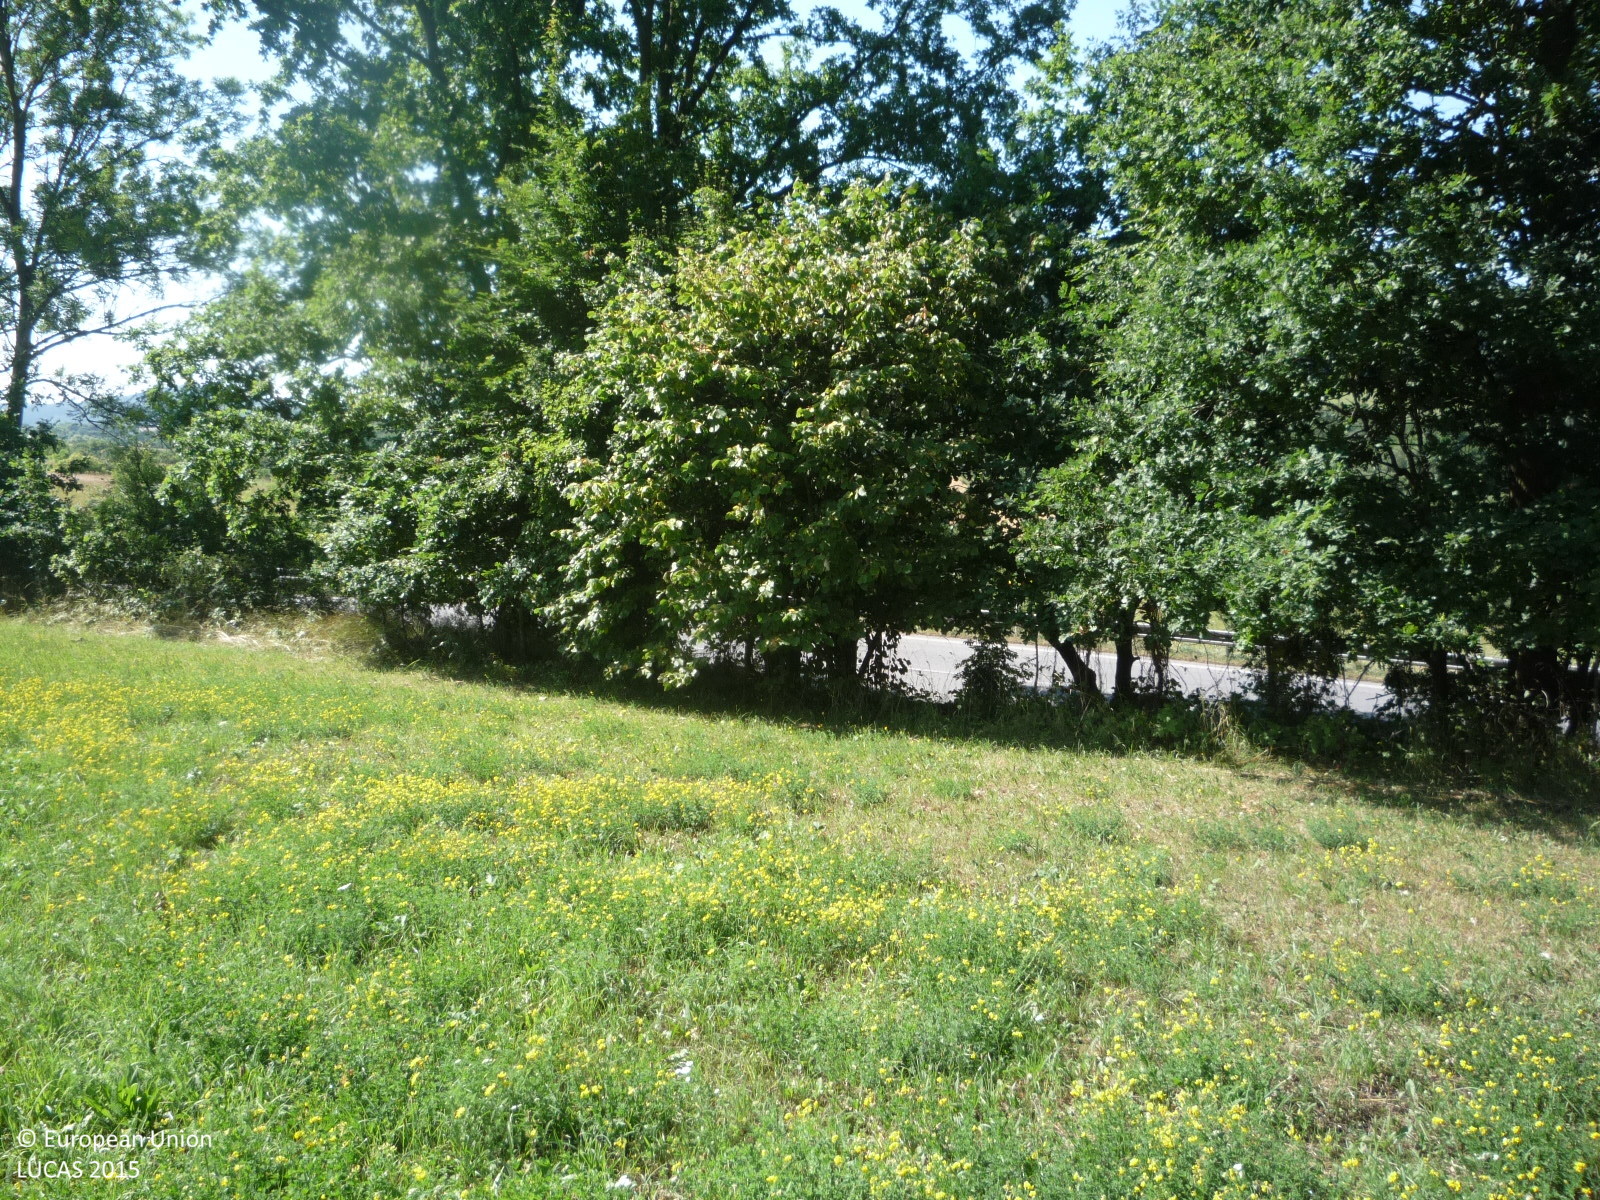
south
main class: Grassland
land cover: Grassland without tree/shrub cover
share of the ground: > 75 %
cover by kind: herbaceous plants 100 %
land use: Agriculture (excluding fallow land and kitchen gardens)
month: July
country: CZ
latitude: 50.5324
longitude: 15.2375
